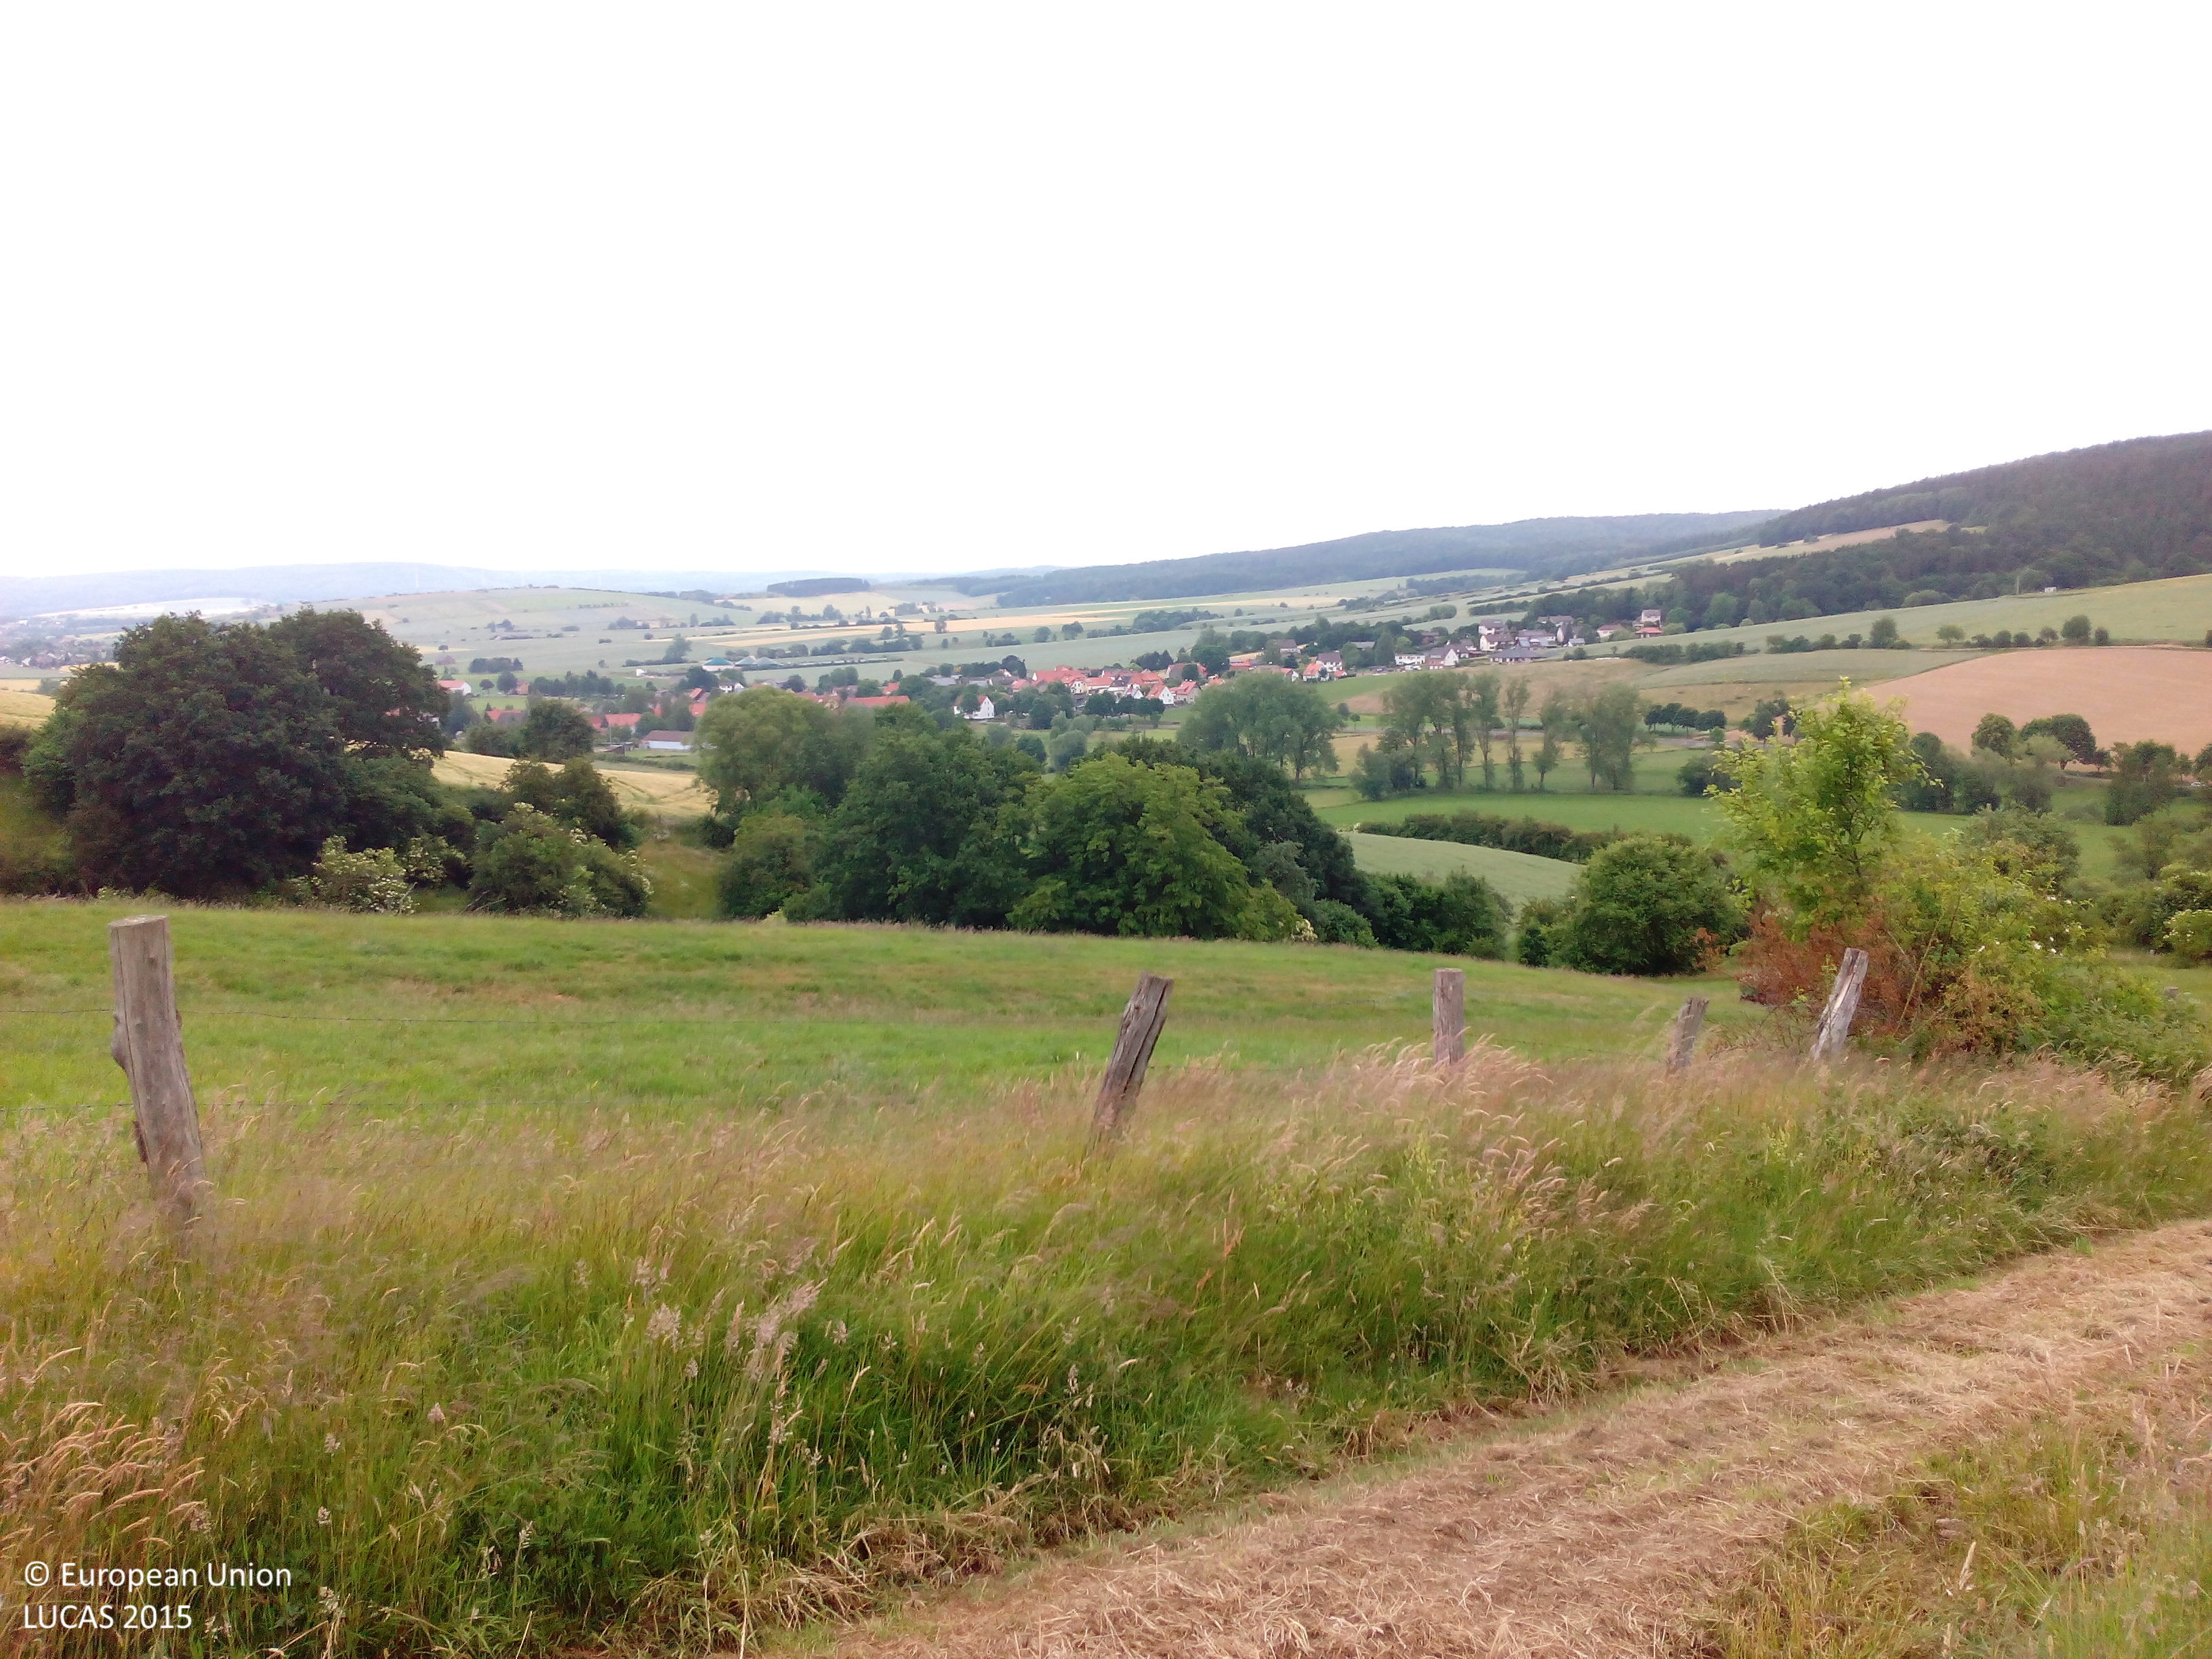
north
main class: Grassland
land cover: Grassland without tree/shrub cover
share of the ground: > 75 %
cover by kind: herbaceous plants 100 %
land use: Agriculture (excluding fallow land and kitchen gardens)
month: June
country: DE
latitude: 51.6041
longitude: 9.6680
